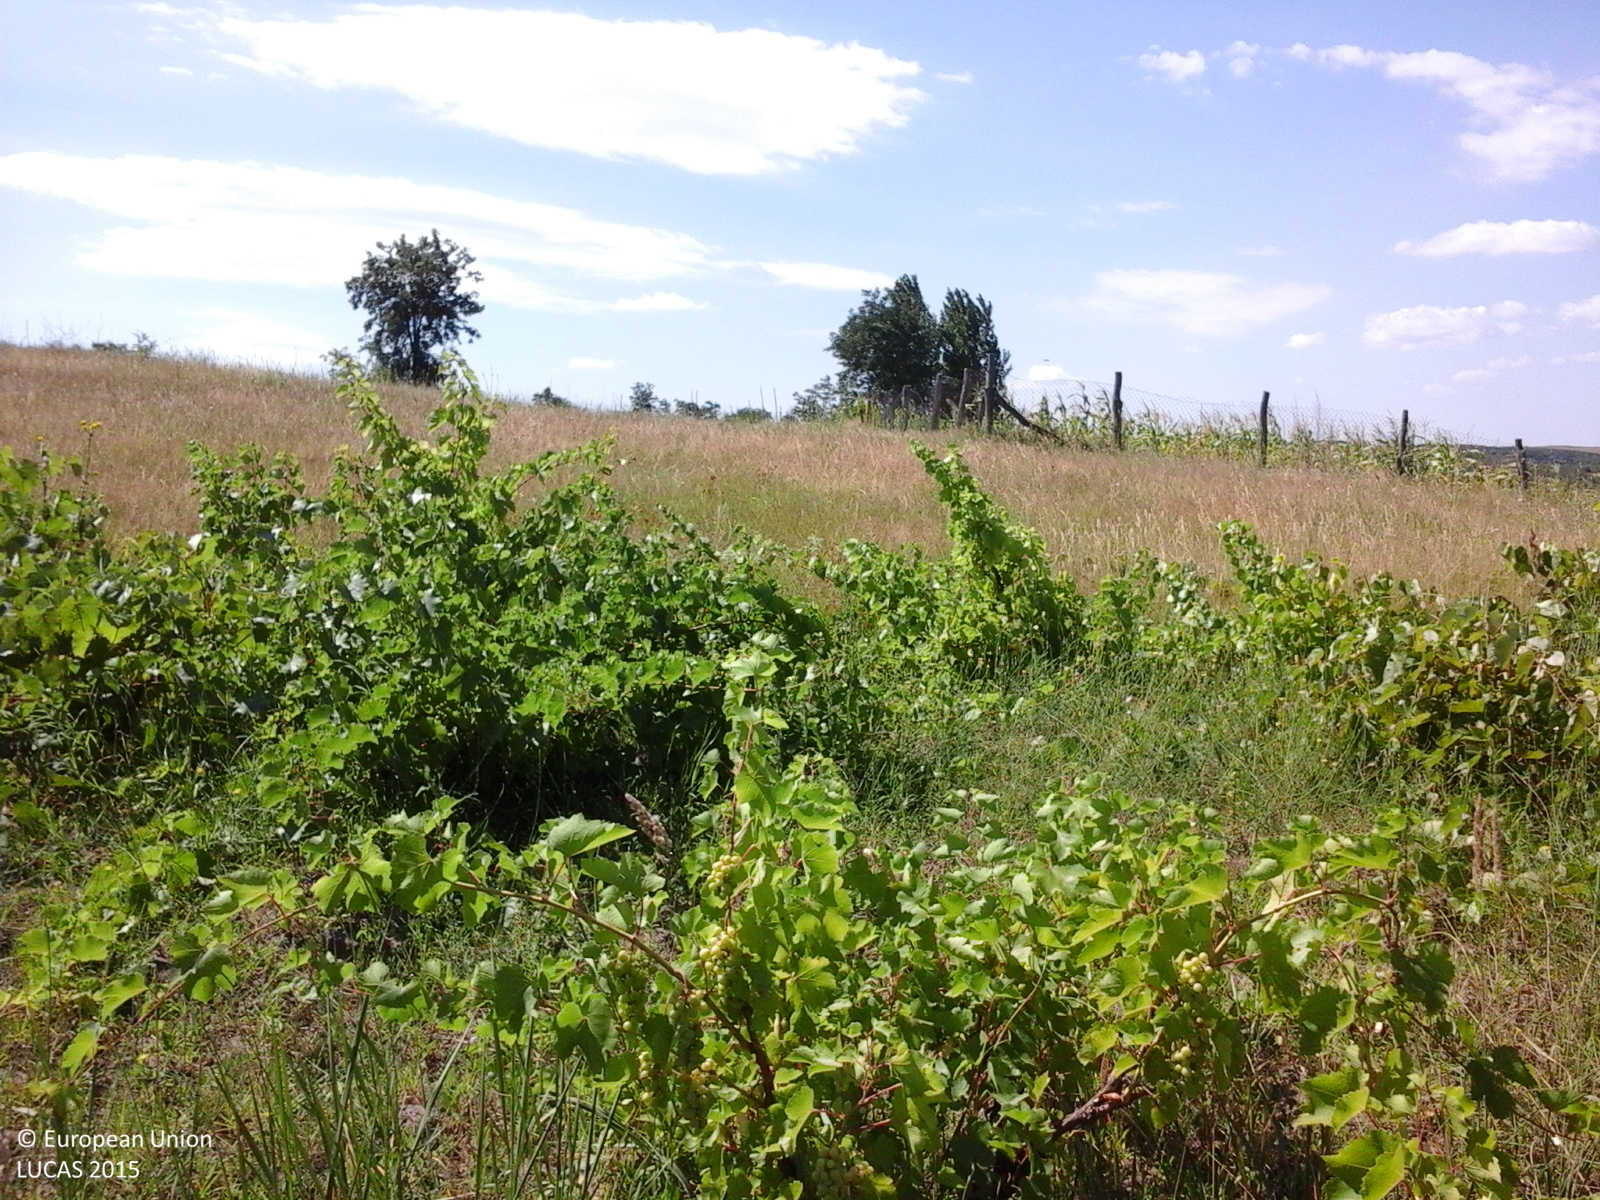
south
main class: Cropland
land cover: Vineyards
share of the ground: > 75 %
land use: Agriculture (excluding fallow land and kitchen gardens)
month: July
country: RO
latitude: 45.9782
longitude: 27.7321
